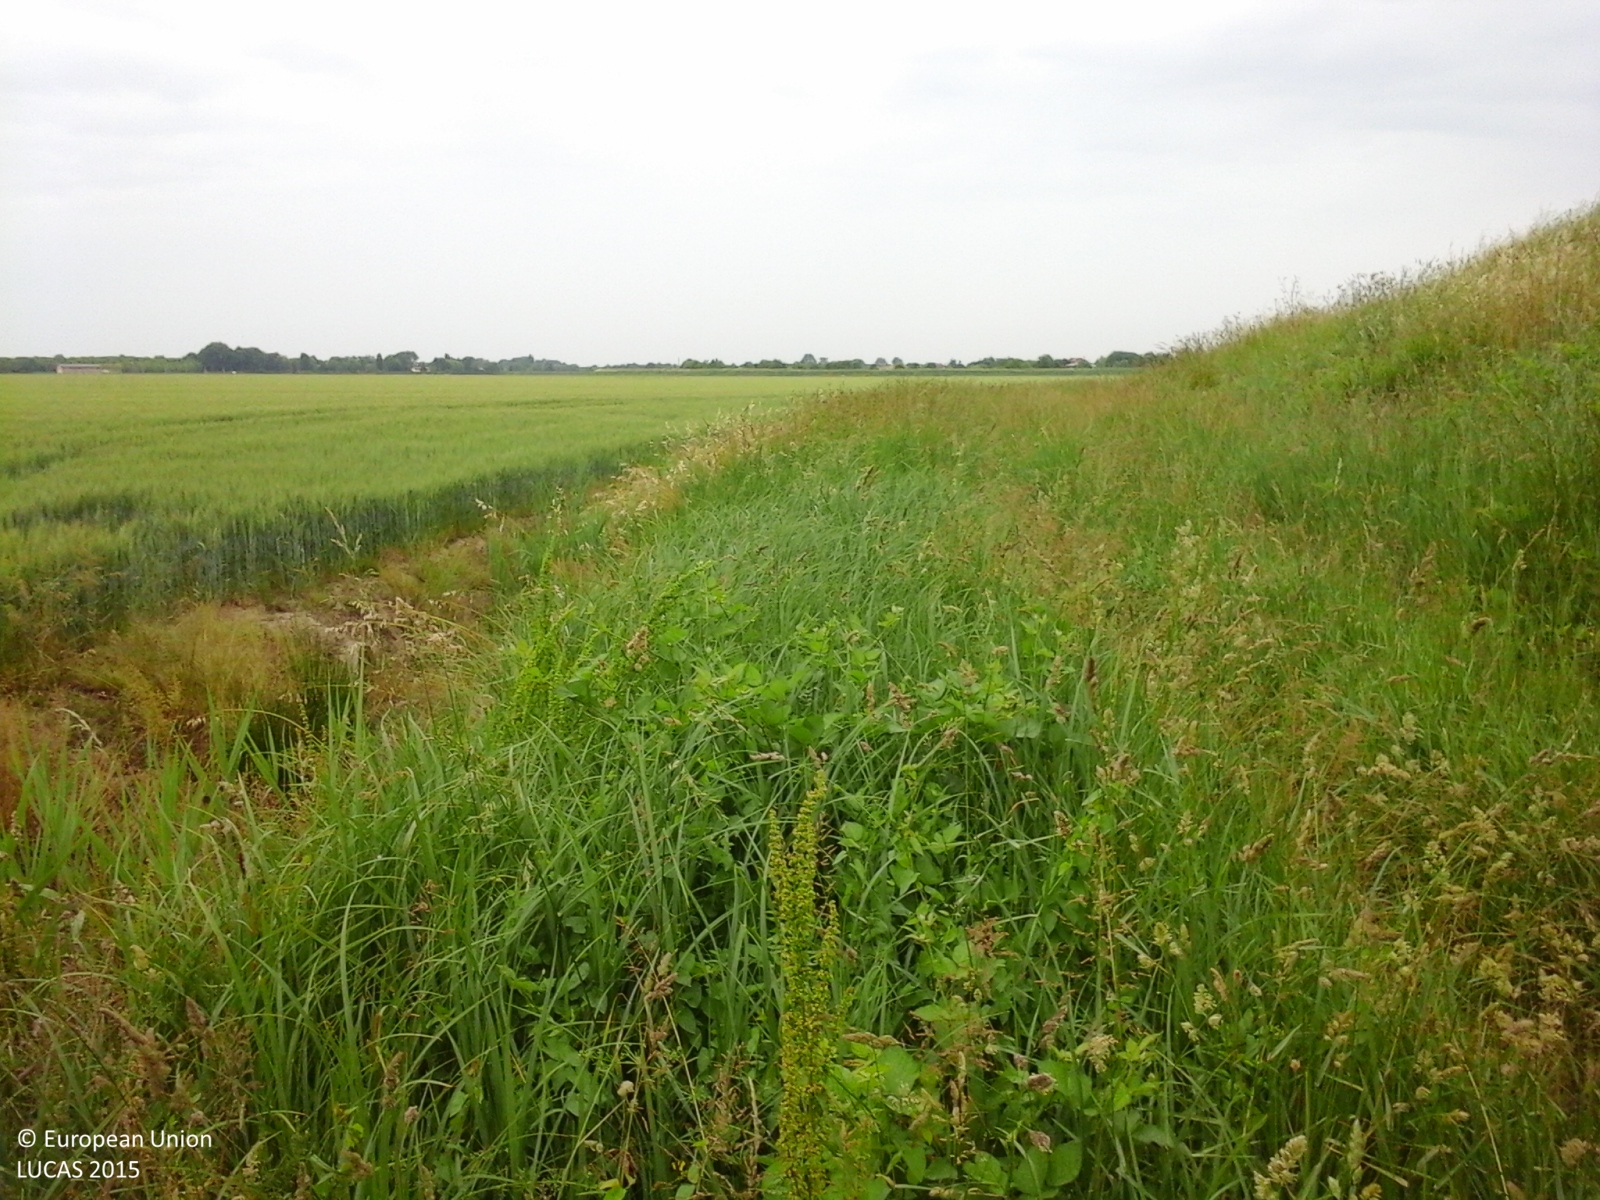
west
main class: Cropland
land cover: Common wheat
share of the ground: > 75 %
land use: Agriculture (excluding fallow land and kitchen gardens)
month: May
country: IT
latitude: 45.5326
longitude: 12.3398
